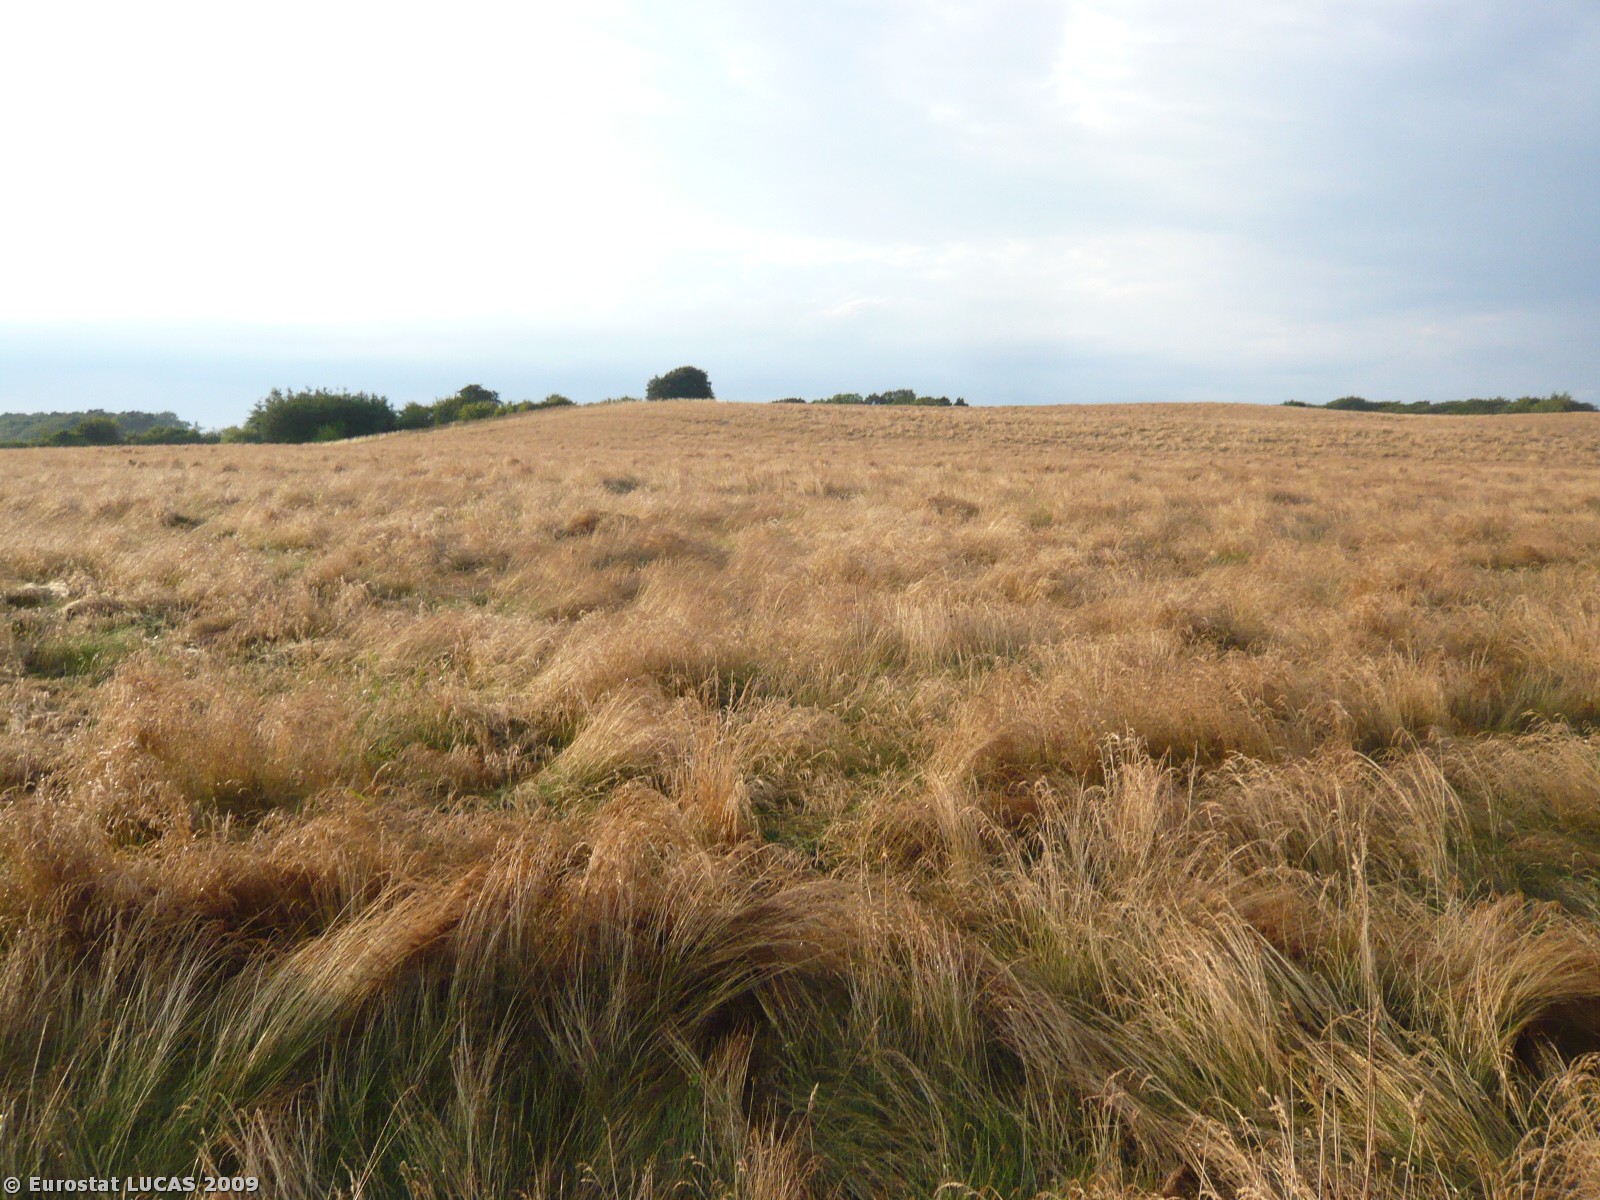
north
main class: Cropland
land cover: Temporary grasslands
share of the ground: > 75 %
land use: Agriculture (excluding fallow land and kitchen gardens)
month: July
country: DK
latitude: 55.6773
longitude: 11.3504
